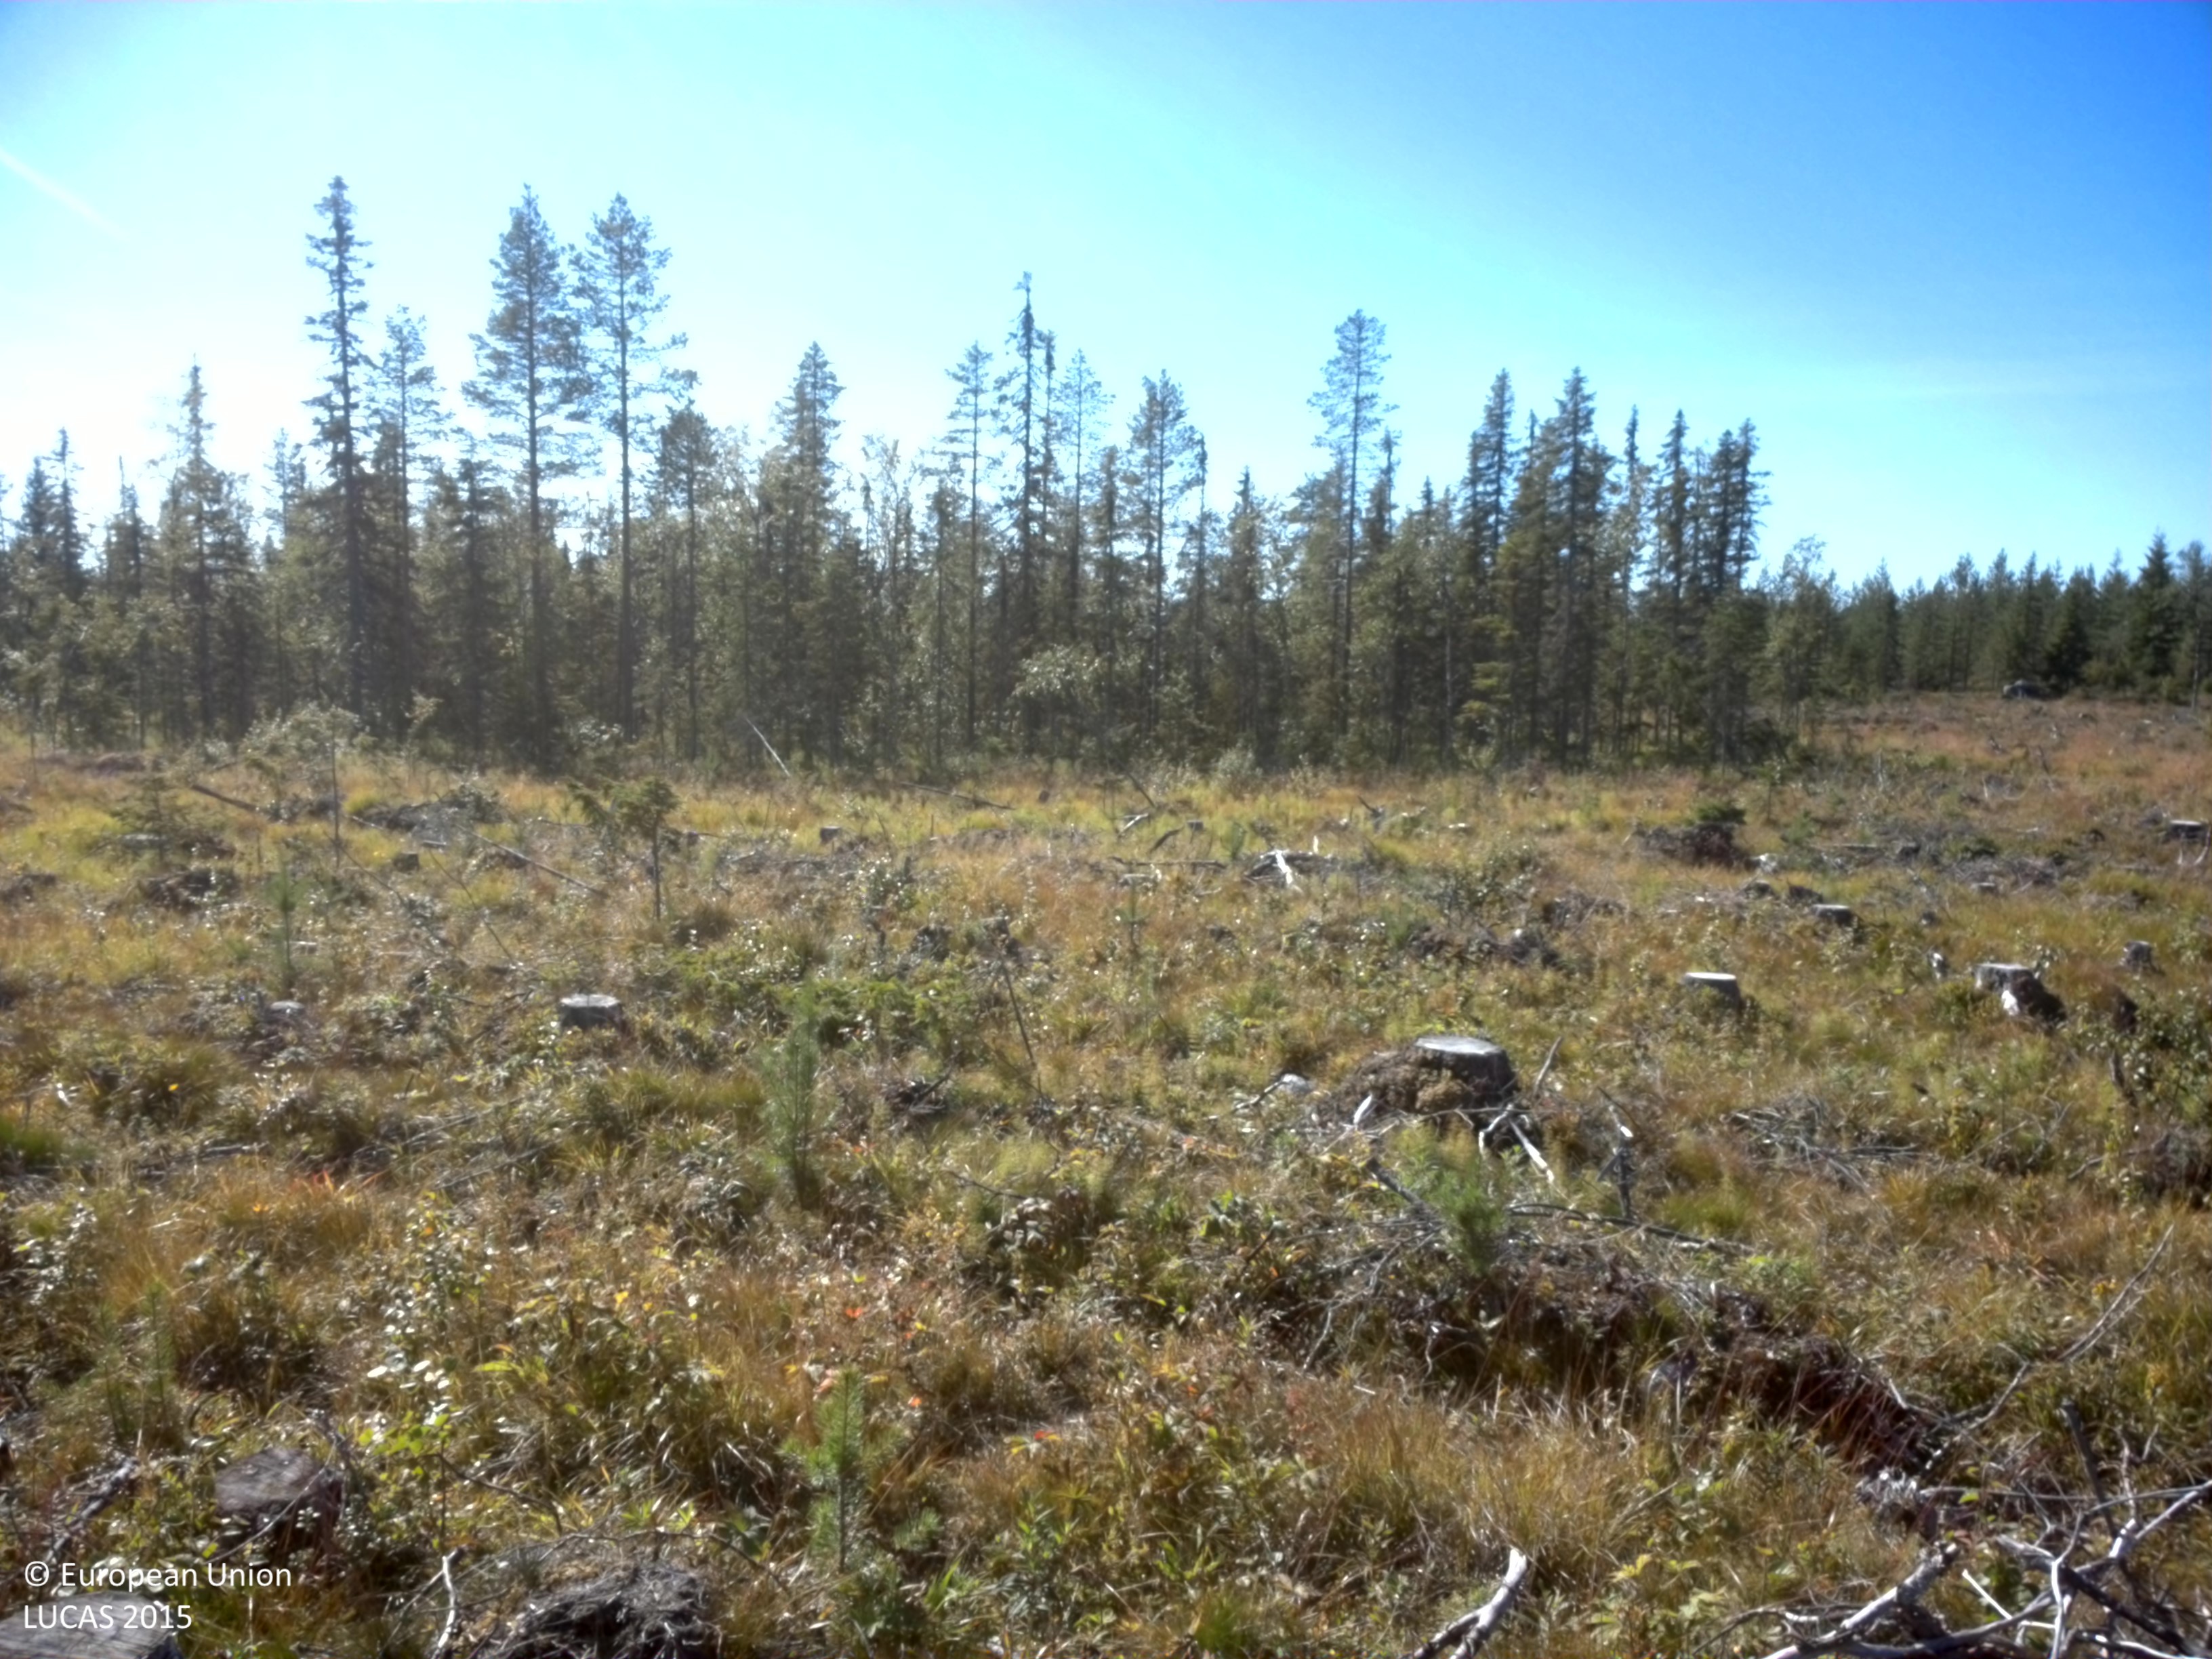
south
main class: Grassland
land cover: Grassland with sparse tree/shrub cover
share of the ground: > 75 %
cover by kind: herbaceous plants 85 %, shrubs 10 %, broadleaved forest trees 5 %
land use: Forestry
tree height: < 5 m
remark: Clear cut
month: August
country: SE
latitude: 64.3039
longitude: 18.7141
